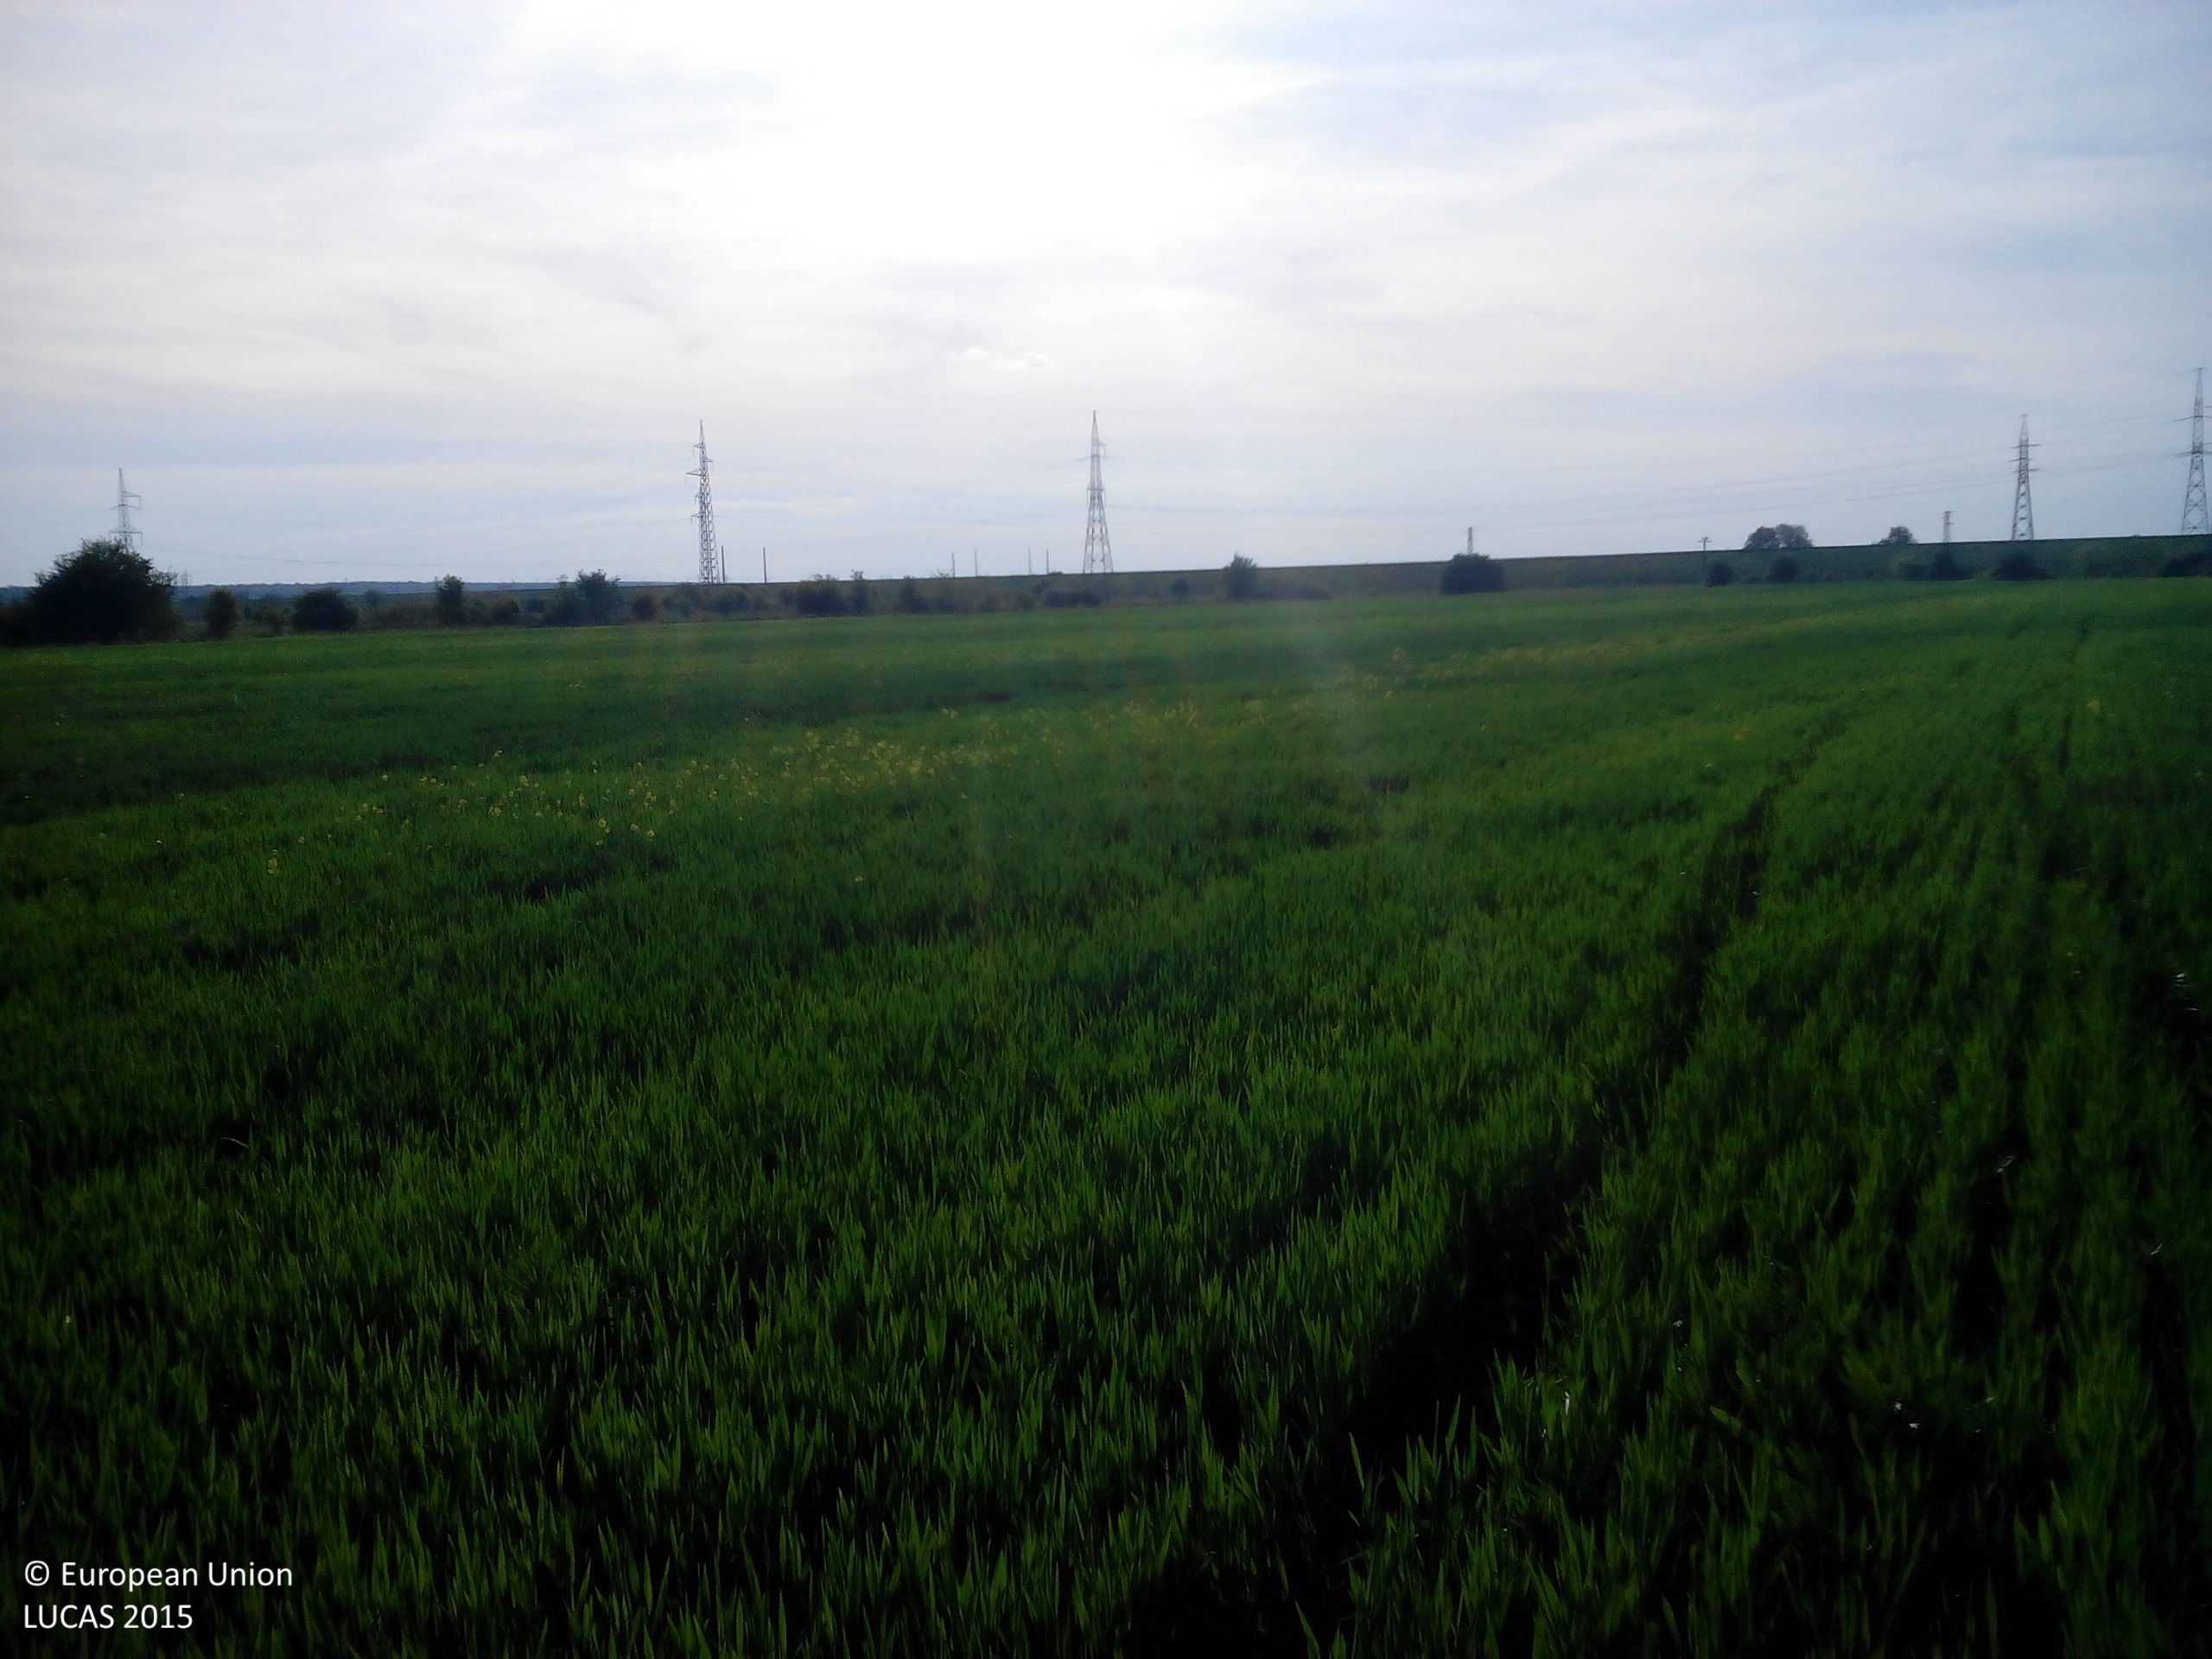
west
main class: Cropland
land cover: Common wheat
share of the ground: > 75 %
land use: Agriculture (excluding fallow land and kitchen gardens)
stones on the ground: < 10 %
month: May
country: BG
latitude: 43.7458
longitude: 23.8489
